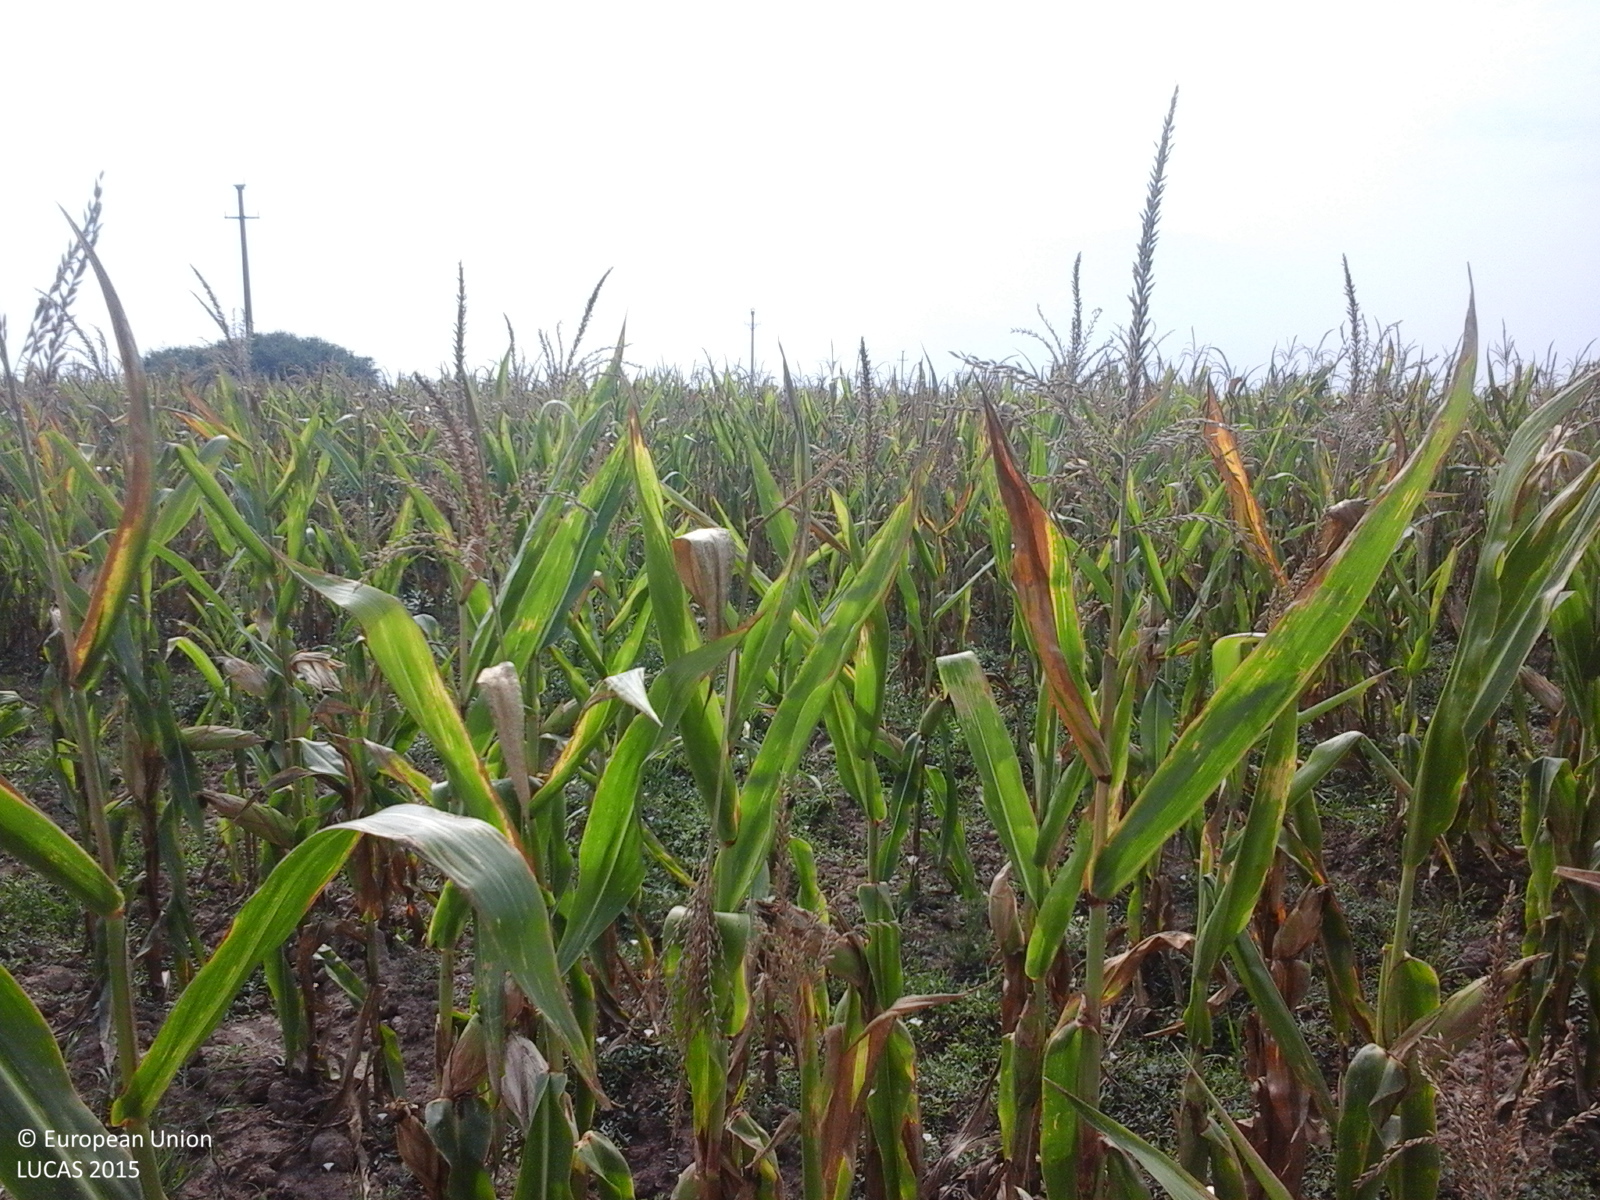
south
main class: Cropland
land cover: Maize
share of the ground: > 75 %
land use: Agriculture (excluding fallow land and kitchen gardens)
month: August
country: RO
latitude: 46.5954
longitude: 21.7236
